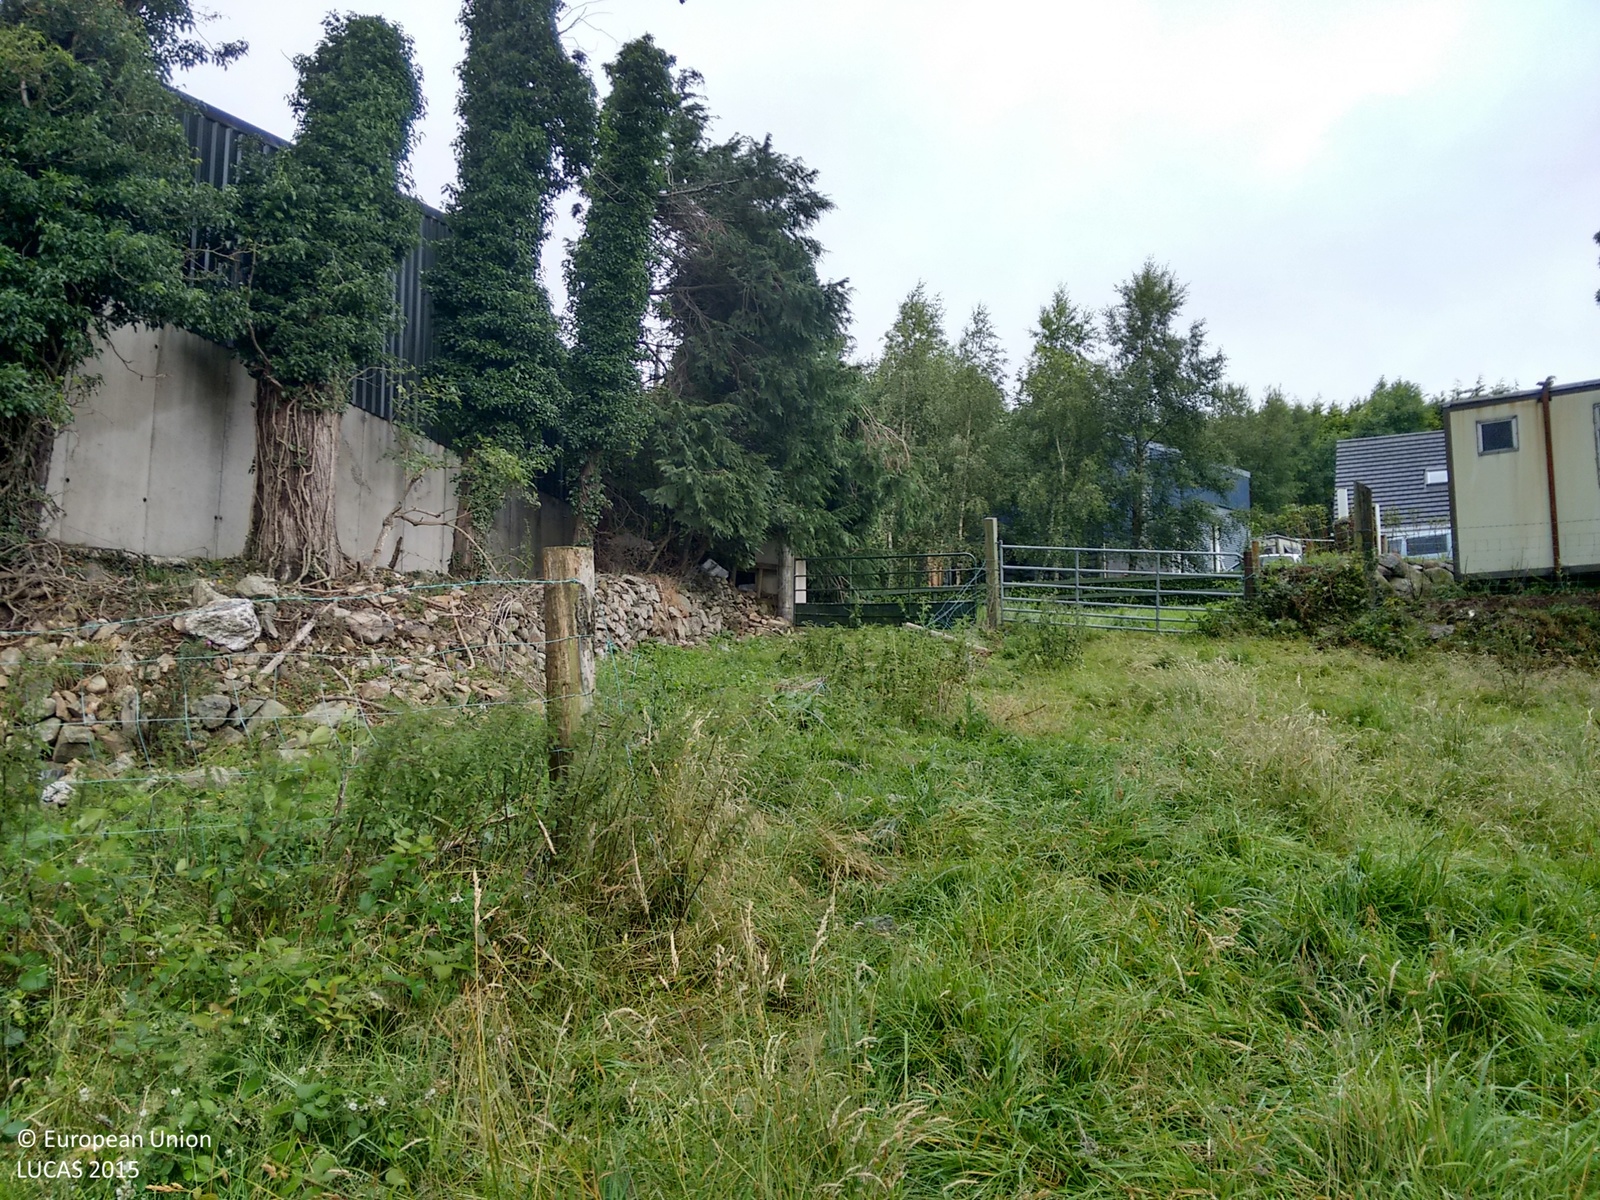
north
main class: Grassland
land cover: Grassland without tree/shrub cover
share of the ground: > 75 %
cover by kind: herbaceous plants 100 %
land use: Agriculture (excluding fallow land and kitchen gardens)
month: July
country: IE
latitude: 52.9305
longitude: -6.2923
